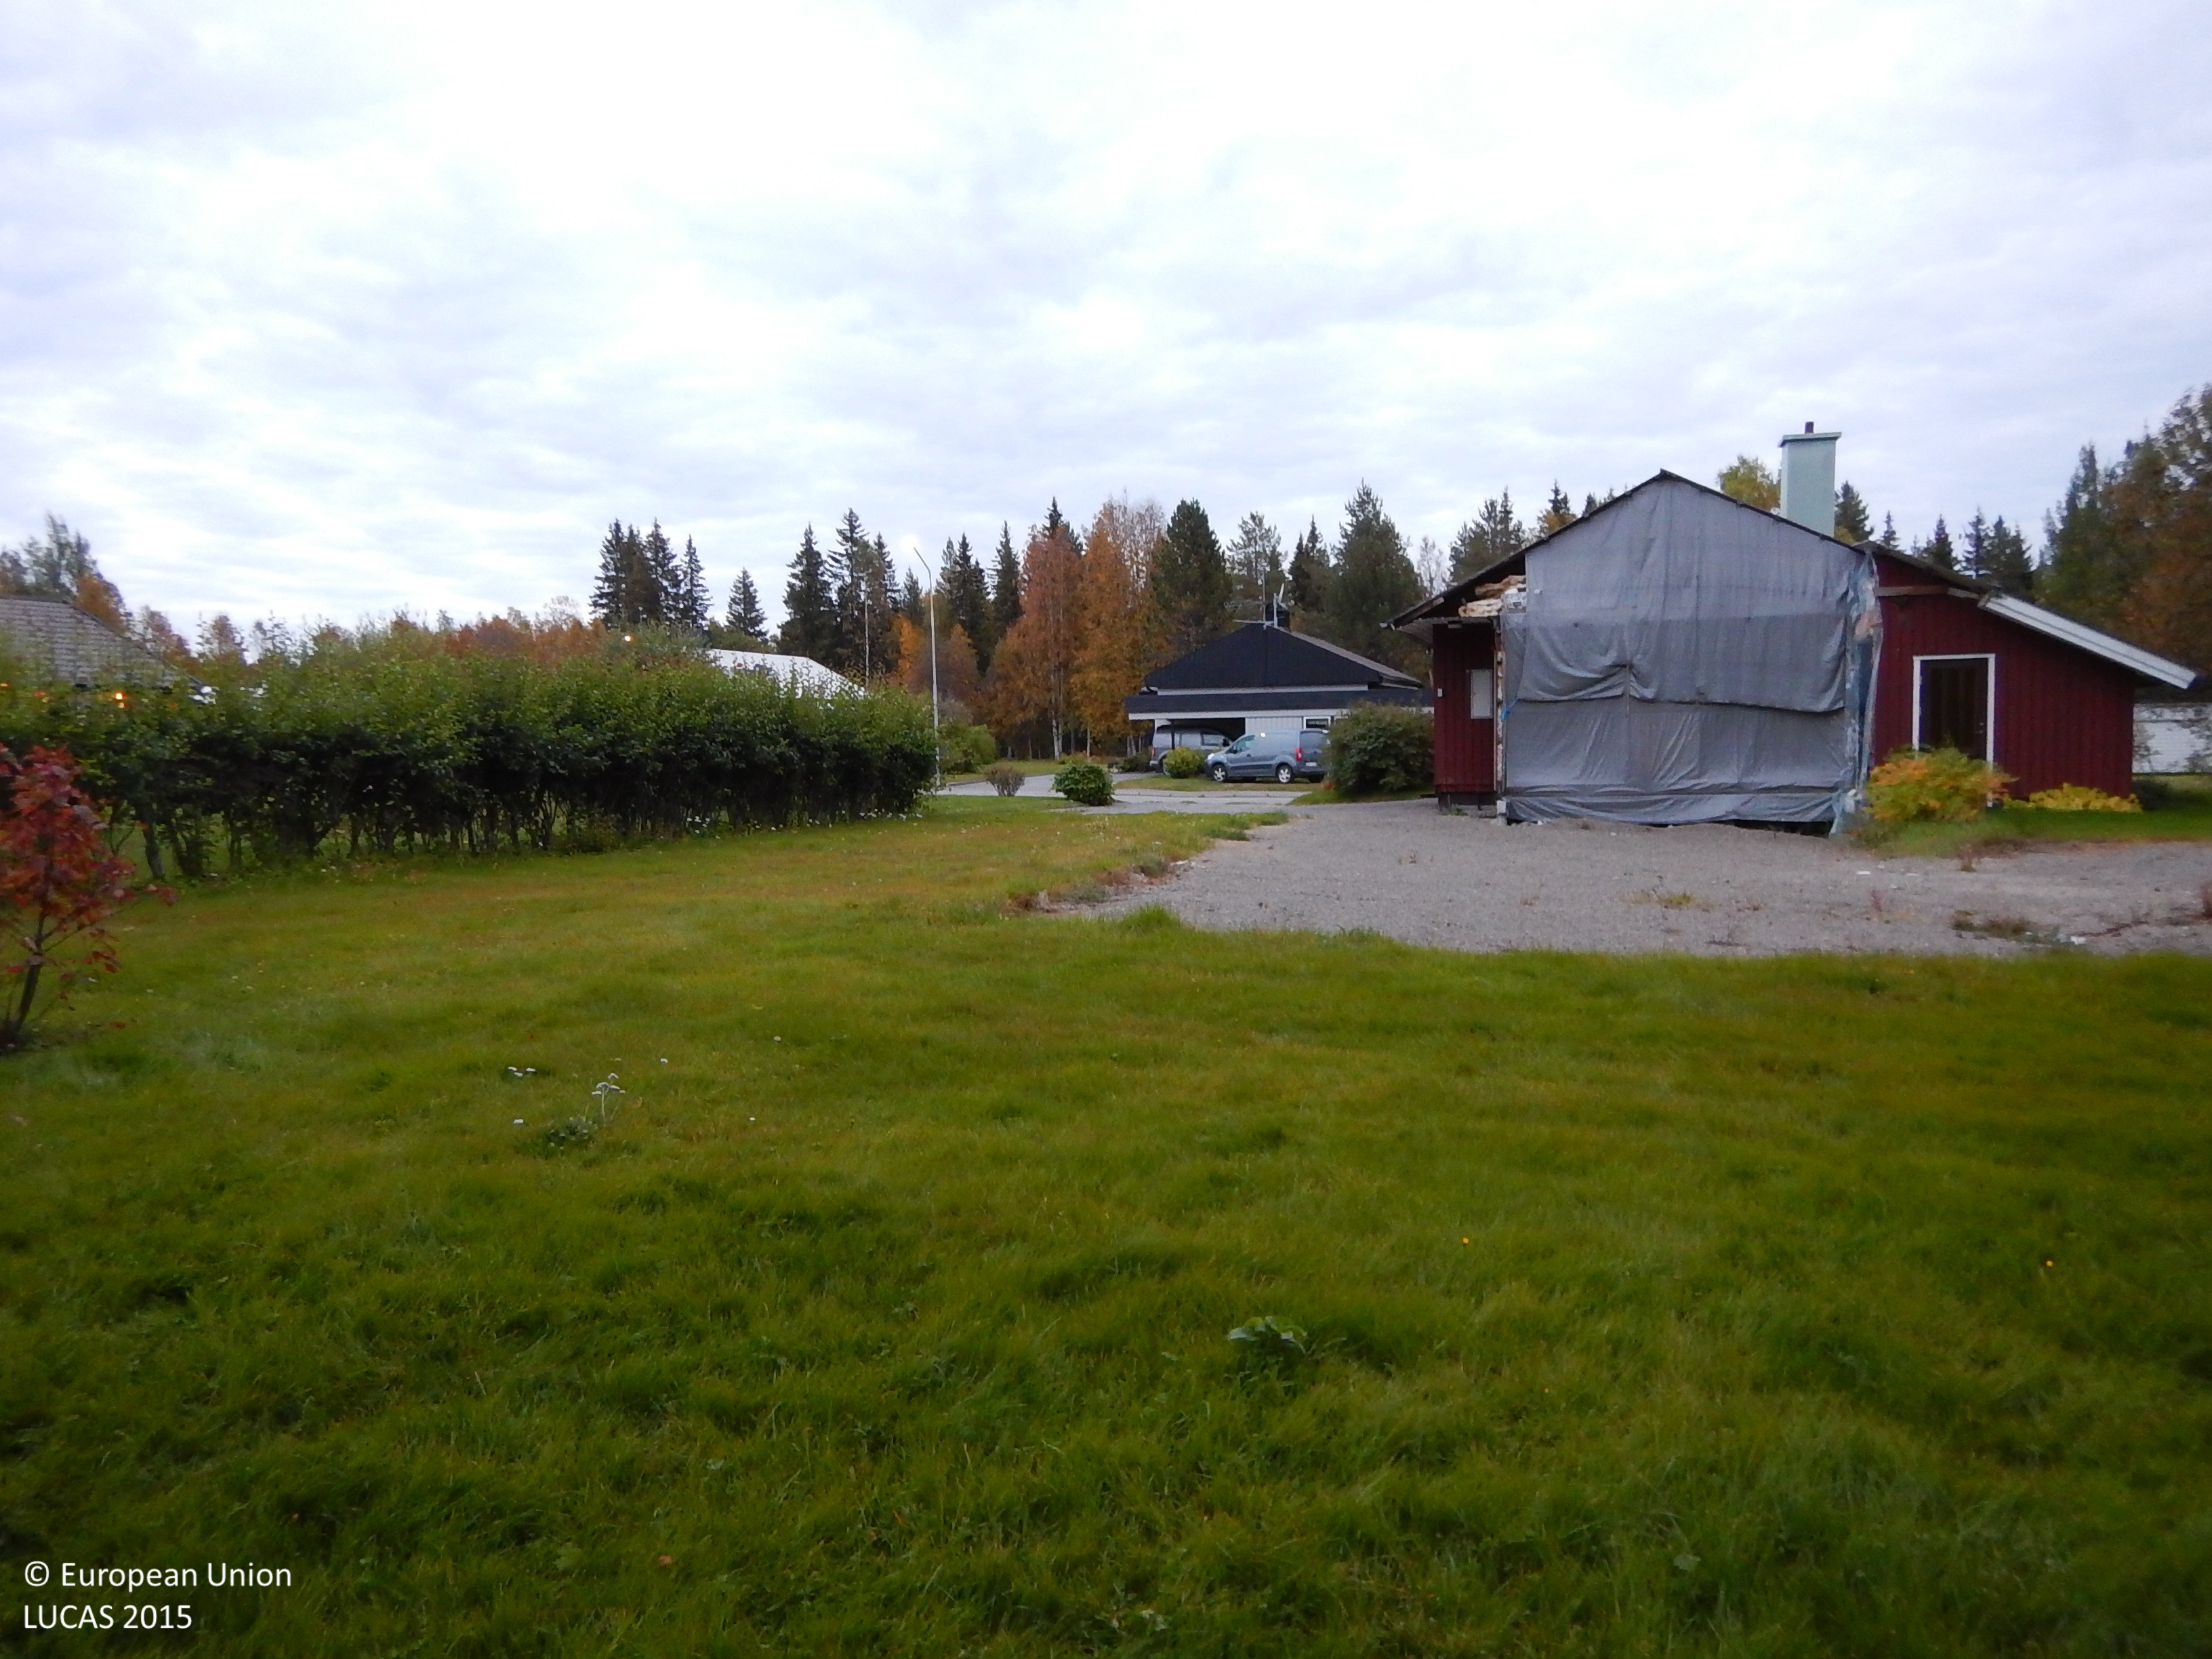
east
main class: Grassland
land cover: Grassland without tree/shrub cover
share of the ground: > 75 %
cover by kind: herbaceous plants 100 %
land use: Residential
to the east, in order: Grassland without tree/shrub cover; Artificial constructions in urban areas; Spruce dominated coniferous woodland; Tracks; Broadleaved woodland; Grass margins; Ditches and canals; Paved roads, cycling and walking lanes; Grass margins
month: September
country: SE
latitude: 64.7898
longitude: 20.0505
